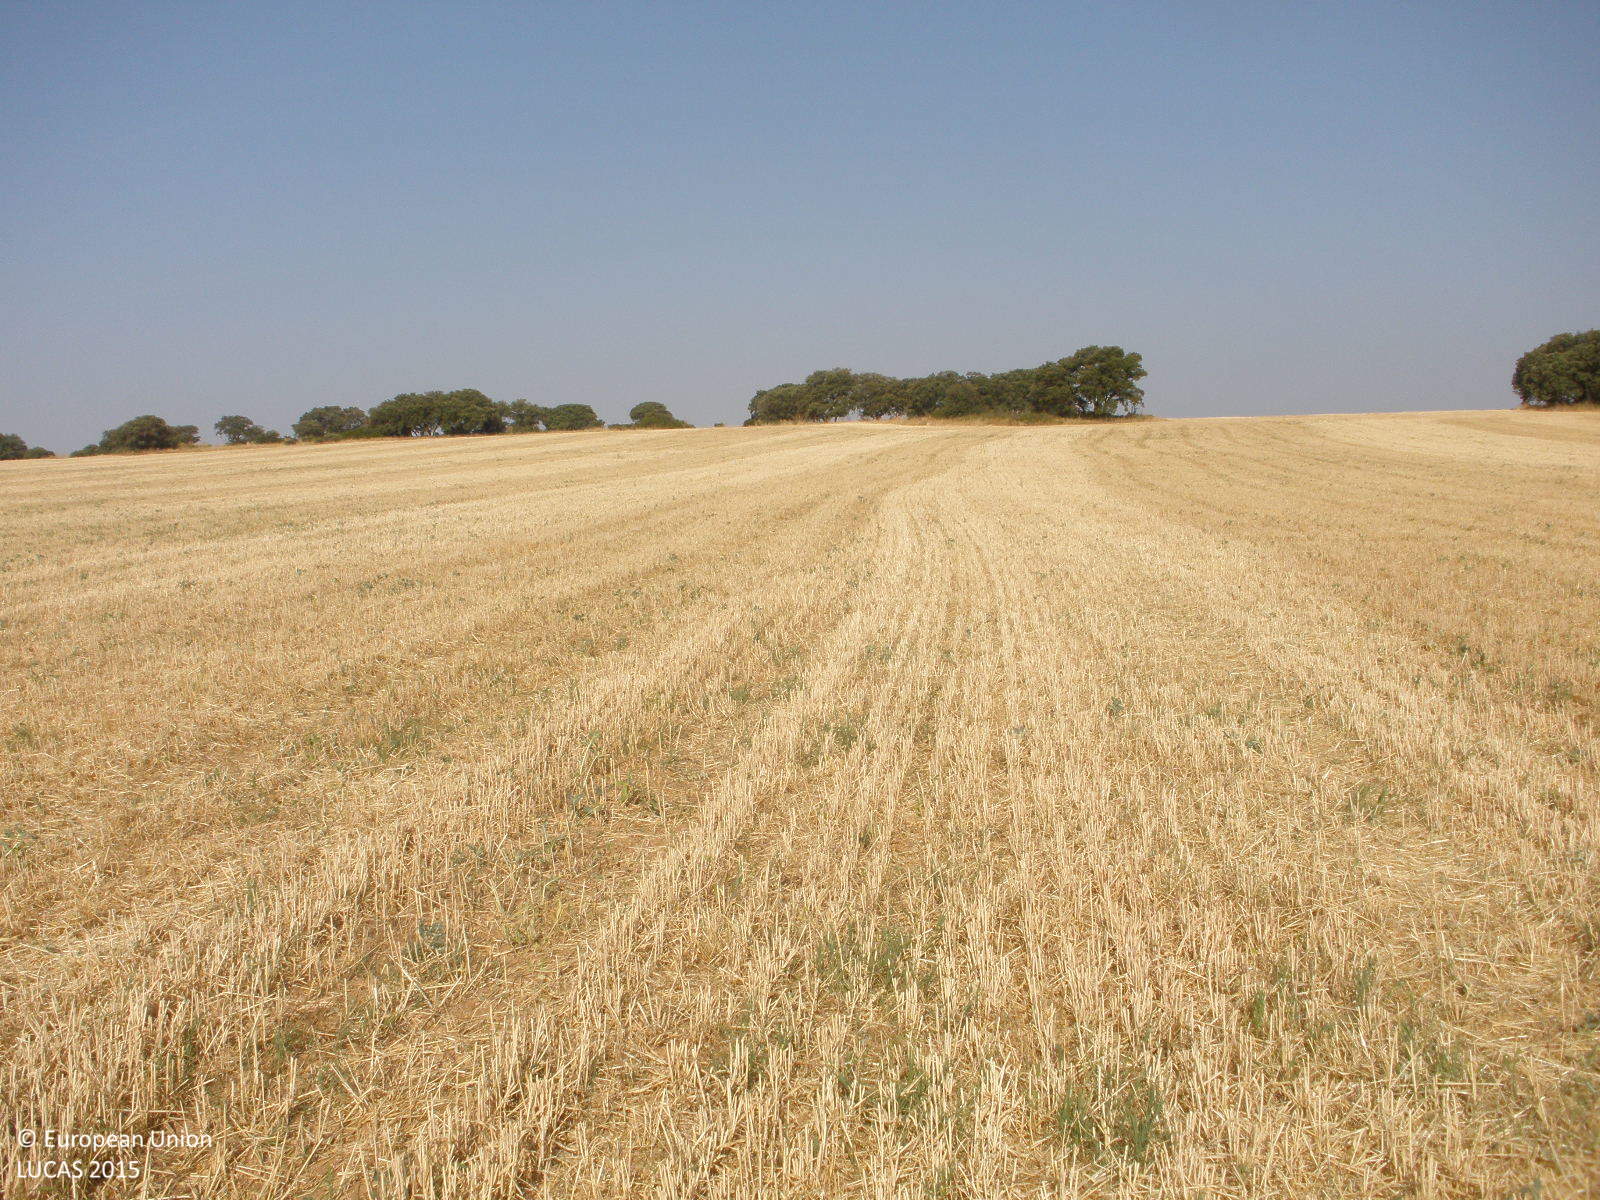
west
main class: Cropland
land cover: Barley
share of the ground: < 10 %
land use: Agriculture (excluding fallow land and kitchen gardens)
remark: Harvested field
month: July
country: ES
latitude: 40.2507
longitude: -3.3271
